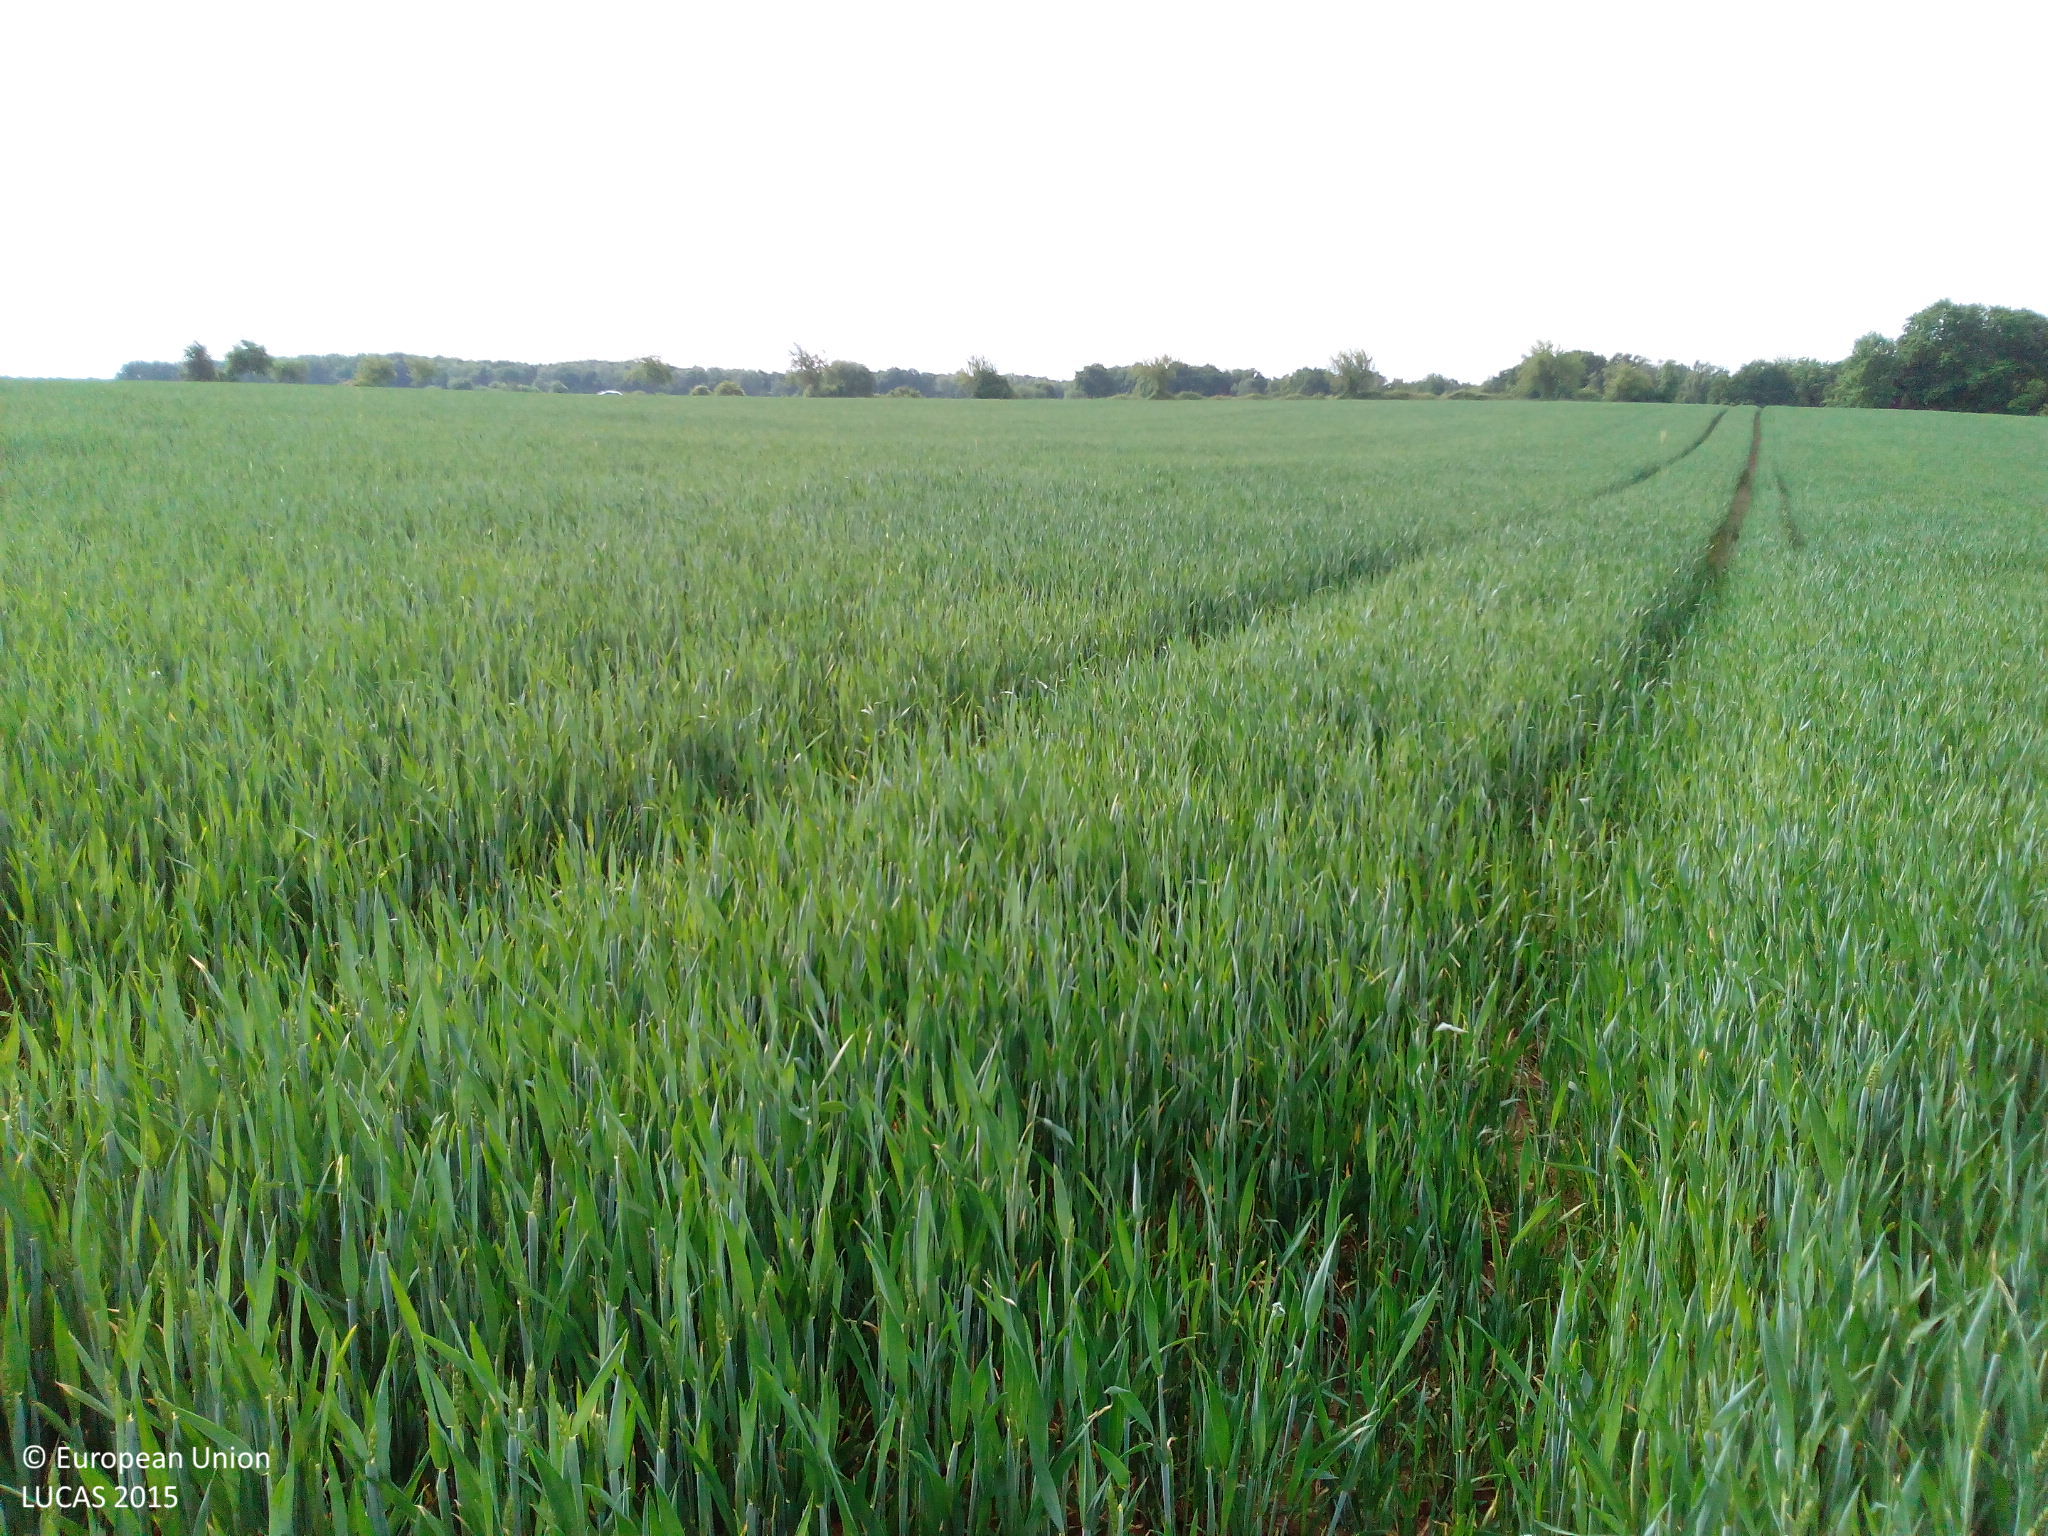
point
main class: Cropland
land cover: Common wheat
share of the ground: > 75 %
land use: Agriculture (excluding fallow land and kitchen gardens)
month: June
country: DE
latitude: 51.5340
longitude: 8.0253
